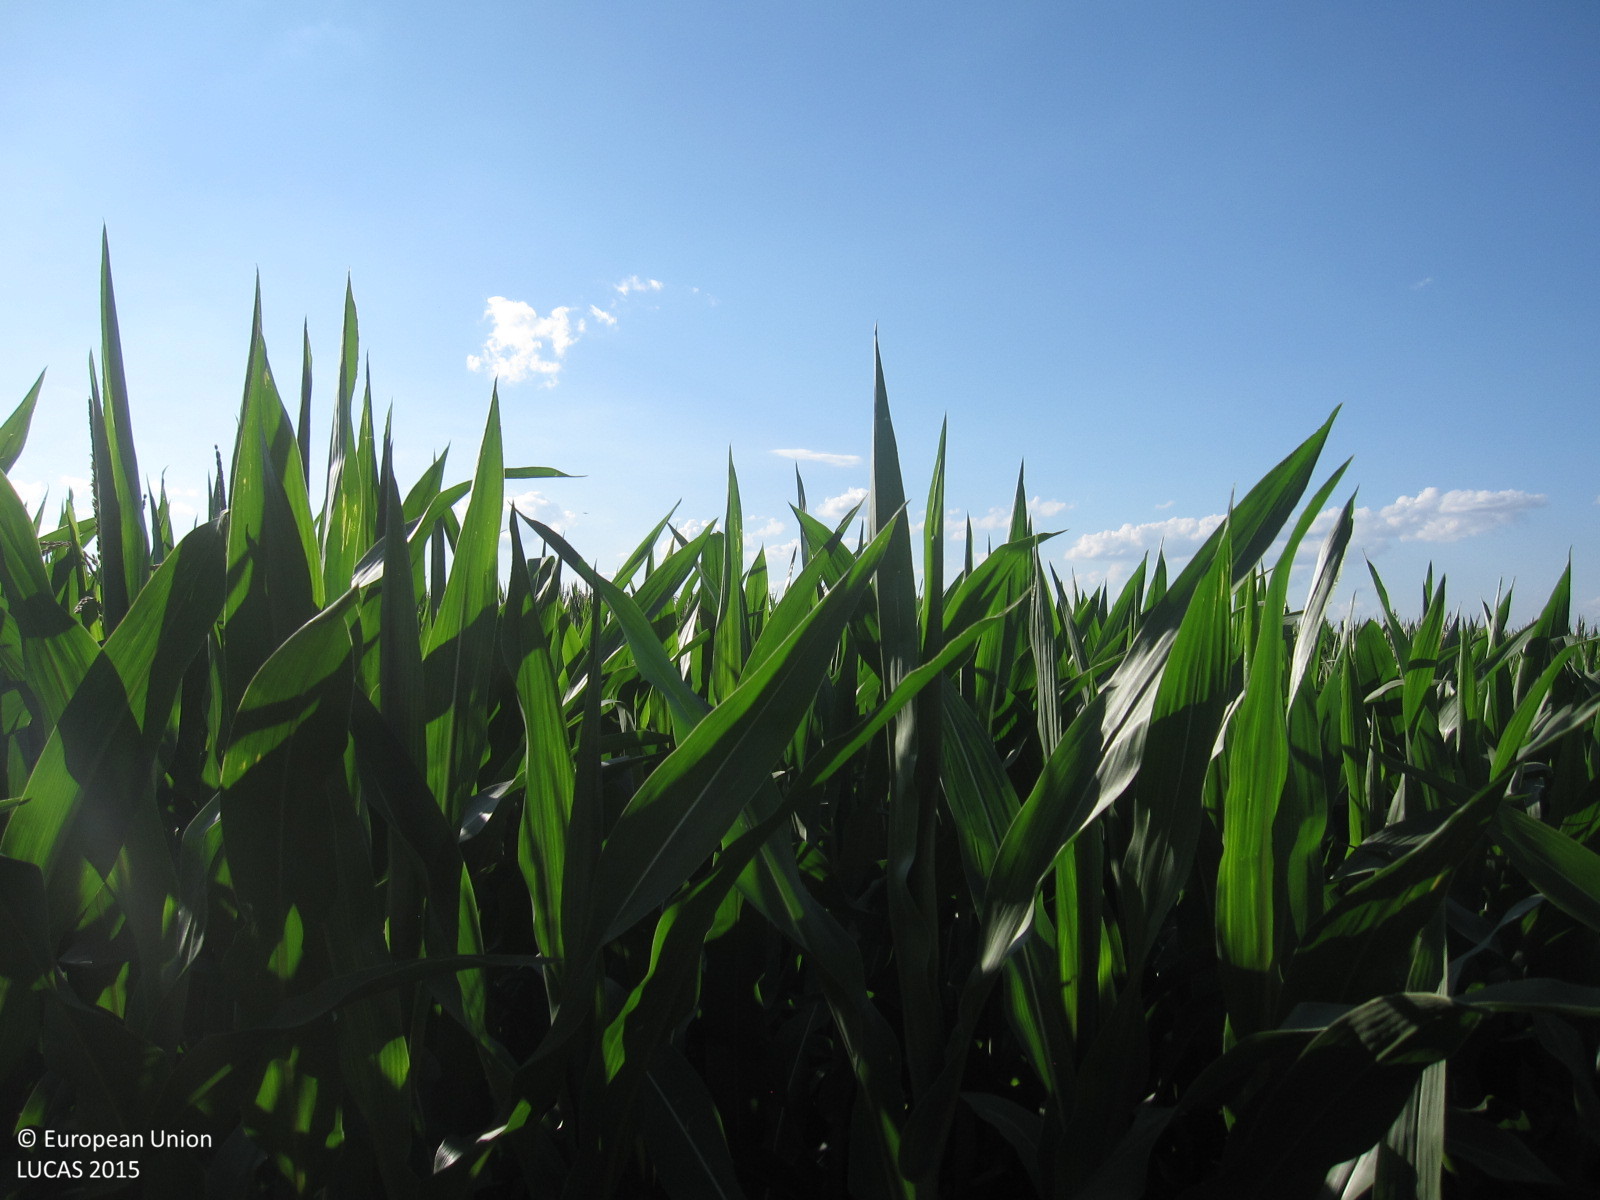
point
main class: Cropland
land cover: Maize
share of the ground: > 75 %
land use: Agriculture (excluding fallow land and kitchen gardens)
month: July
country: DE
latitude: 51.0088
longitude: 12.1803
